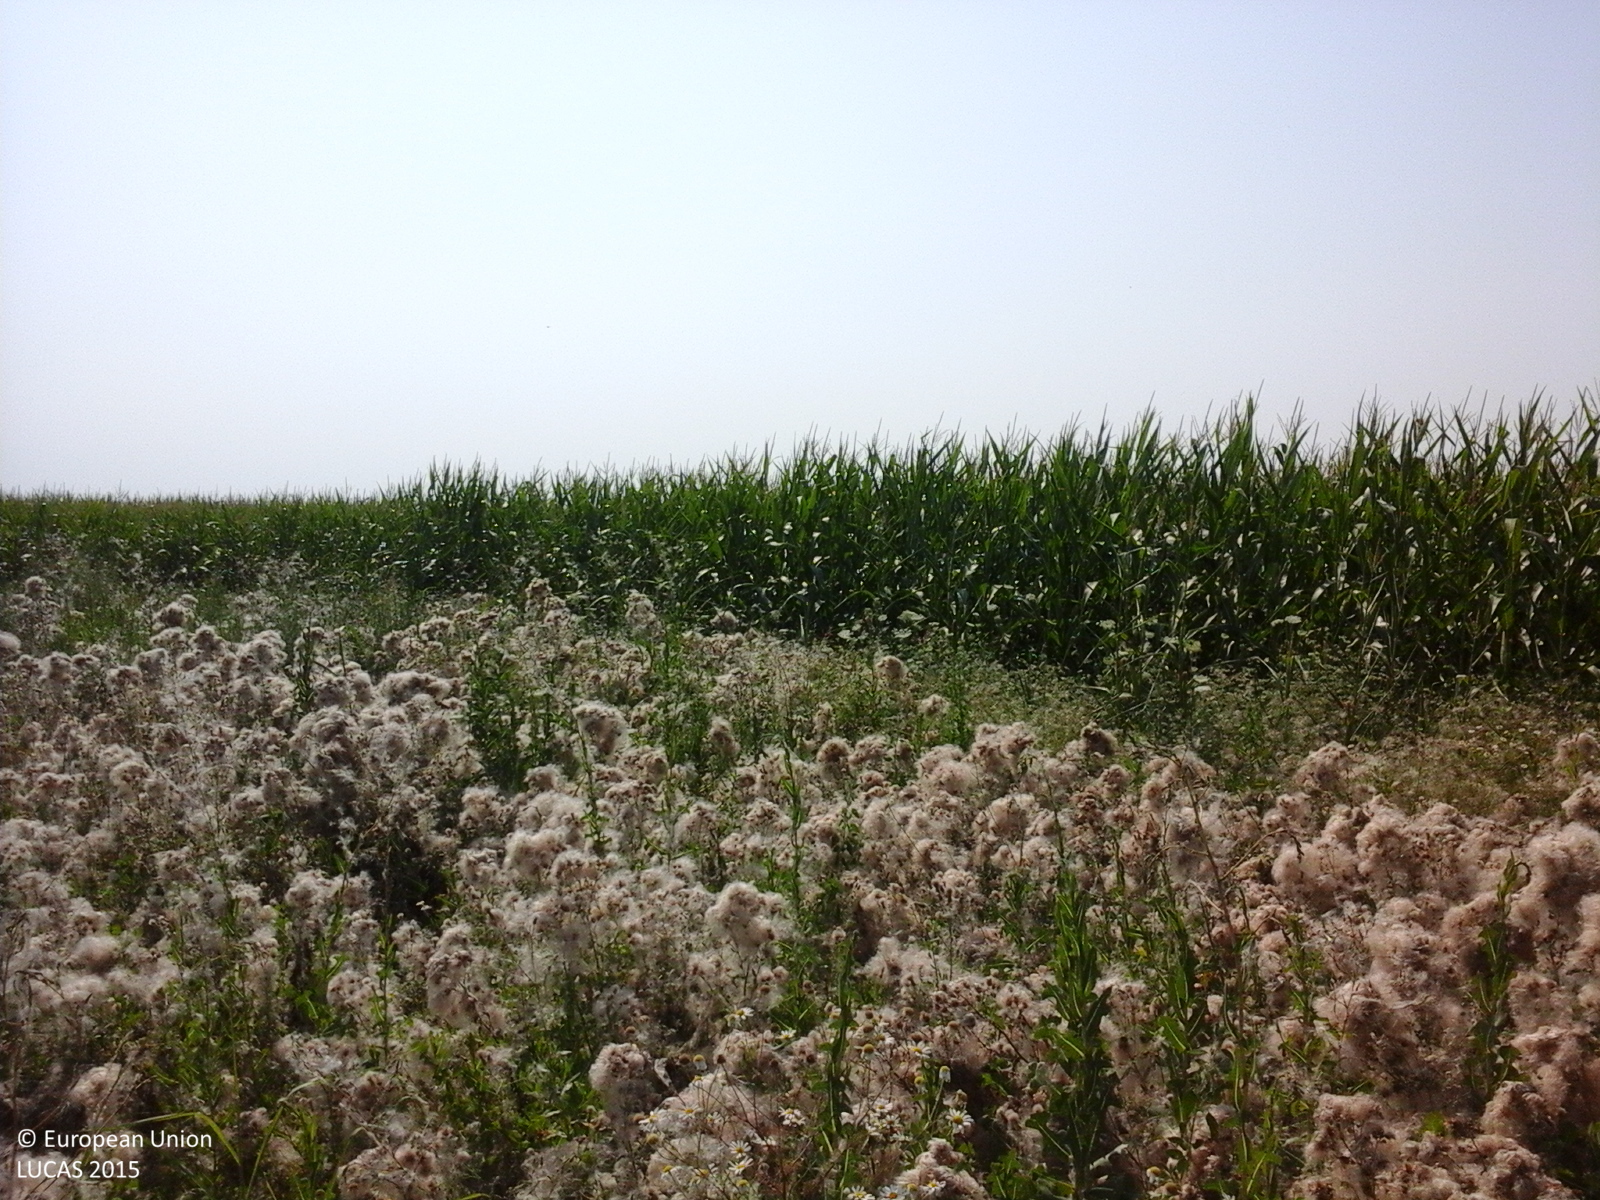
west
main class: Cropland
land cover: Maize
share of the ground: > 75 %
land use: Agriculture (excluding fallow land and kitchen gardens)
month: July
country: RO
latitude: 44.8168
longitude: 26.8586
